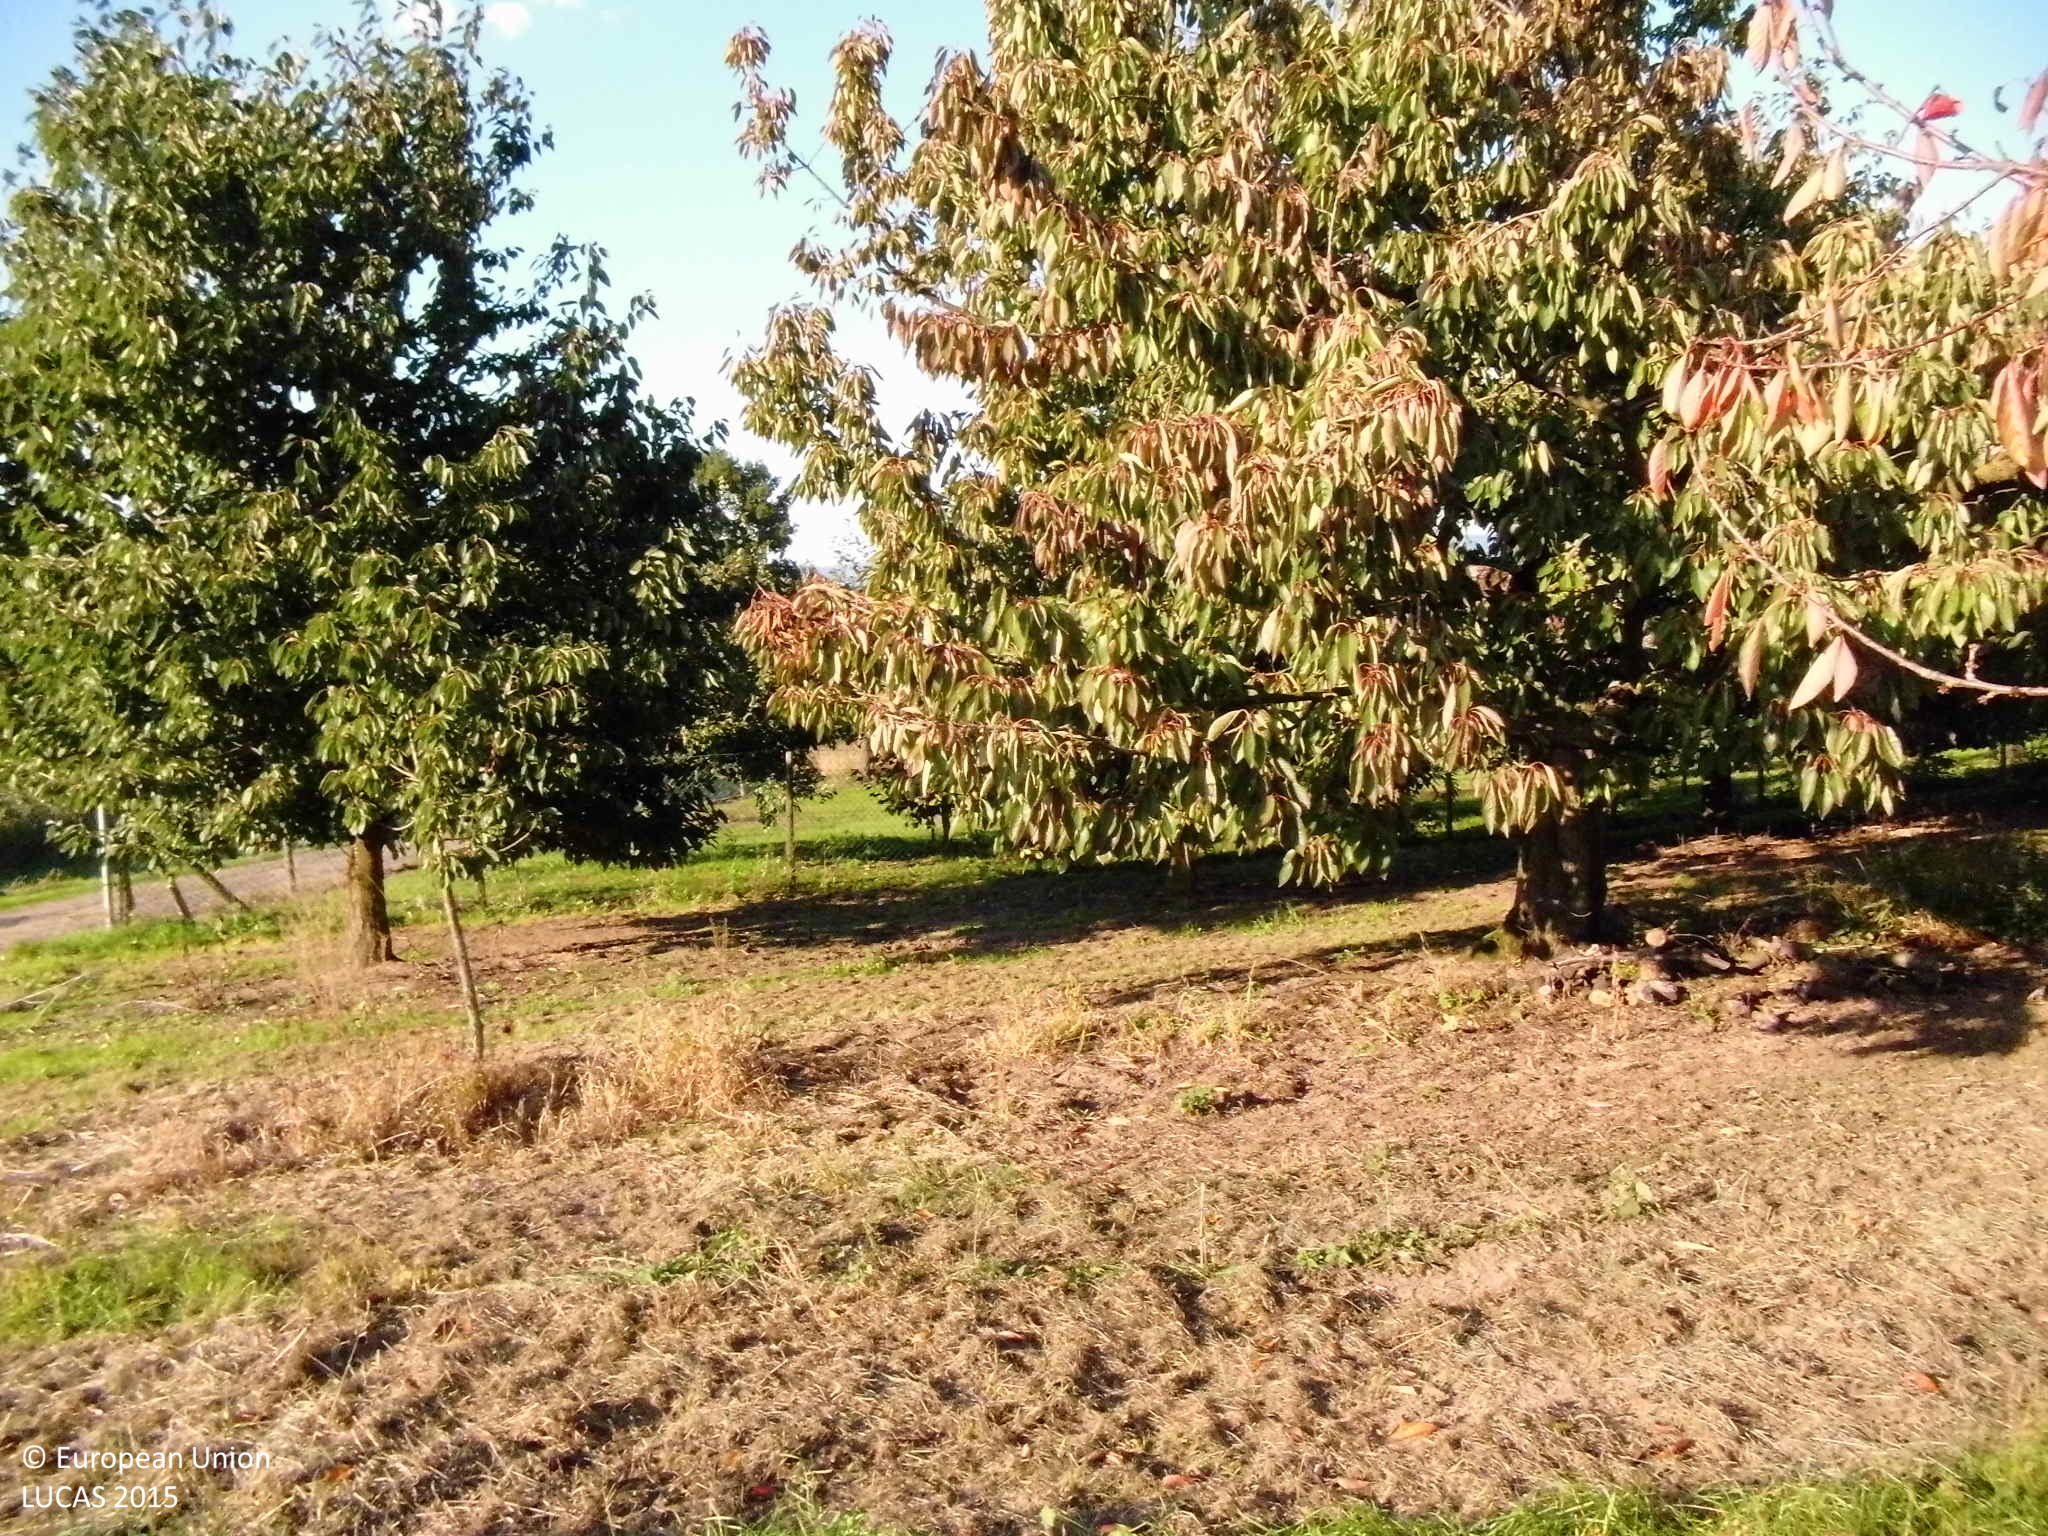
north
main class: Cropland
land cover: Cherry fruit
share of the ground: 25 - 50 %
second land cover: Grassland without tree/shrub cover
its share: > 75 %
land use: Agriculture (excluding fallow land and kitchen gardens)
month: September
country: DE
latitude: 50.3724
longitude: 7.4835
